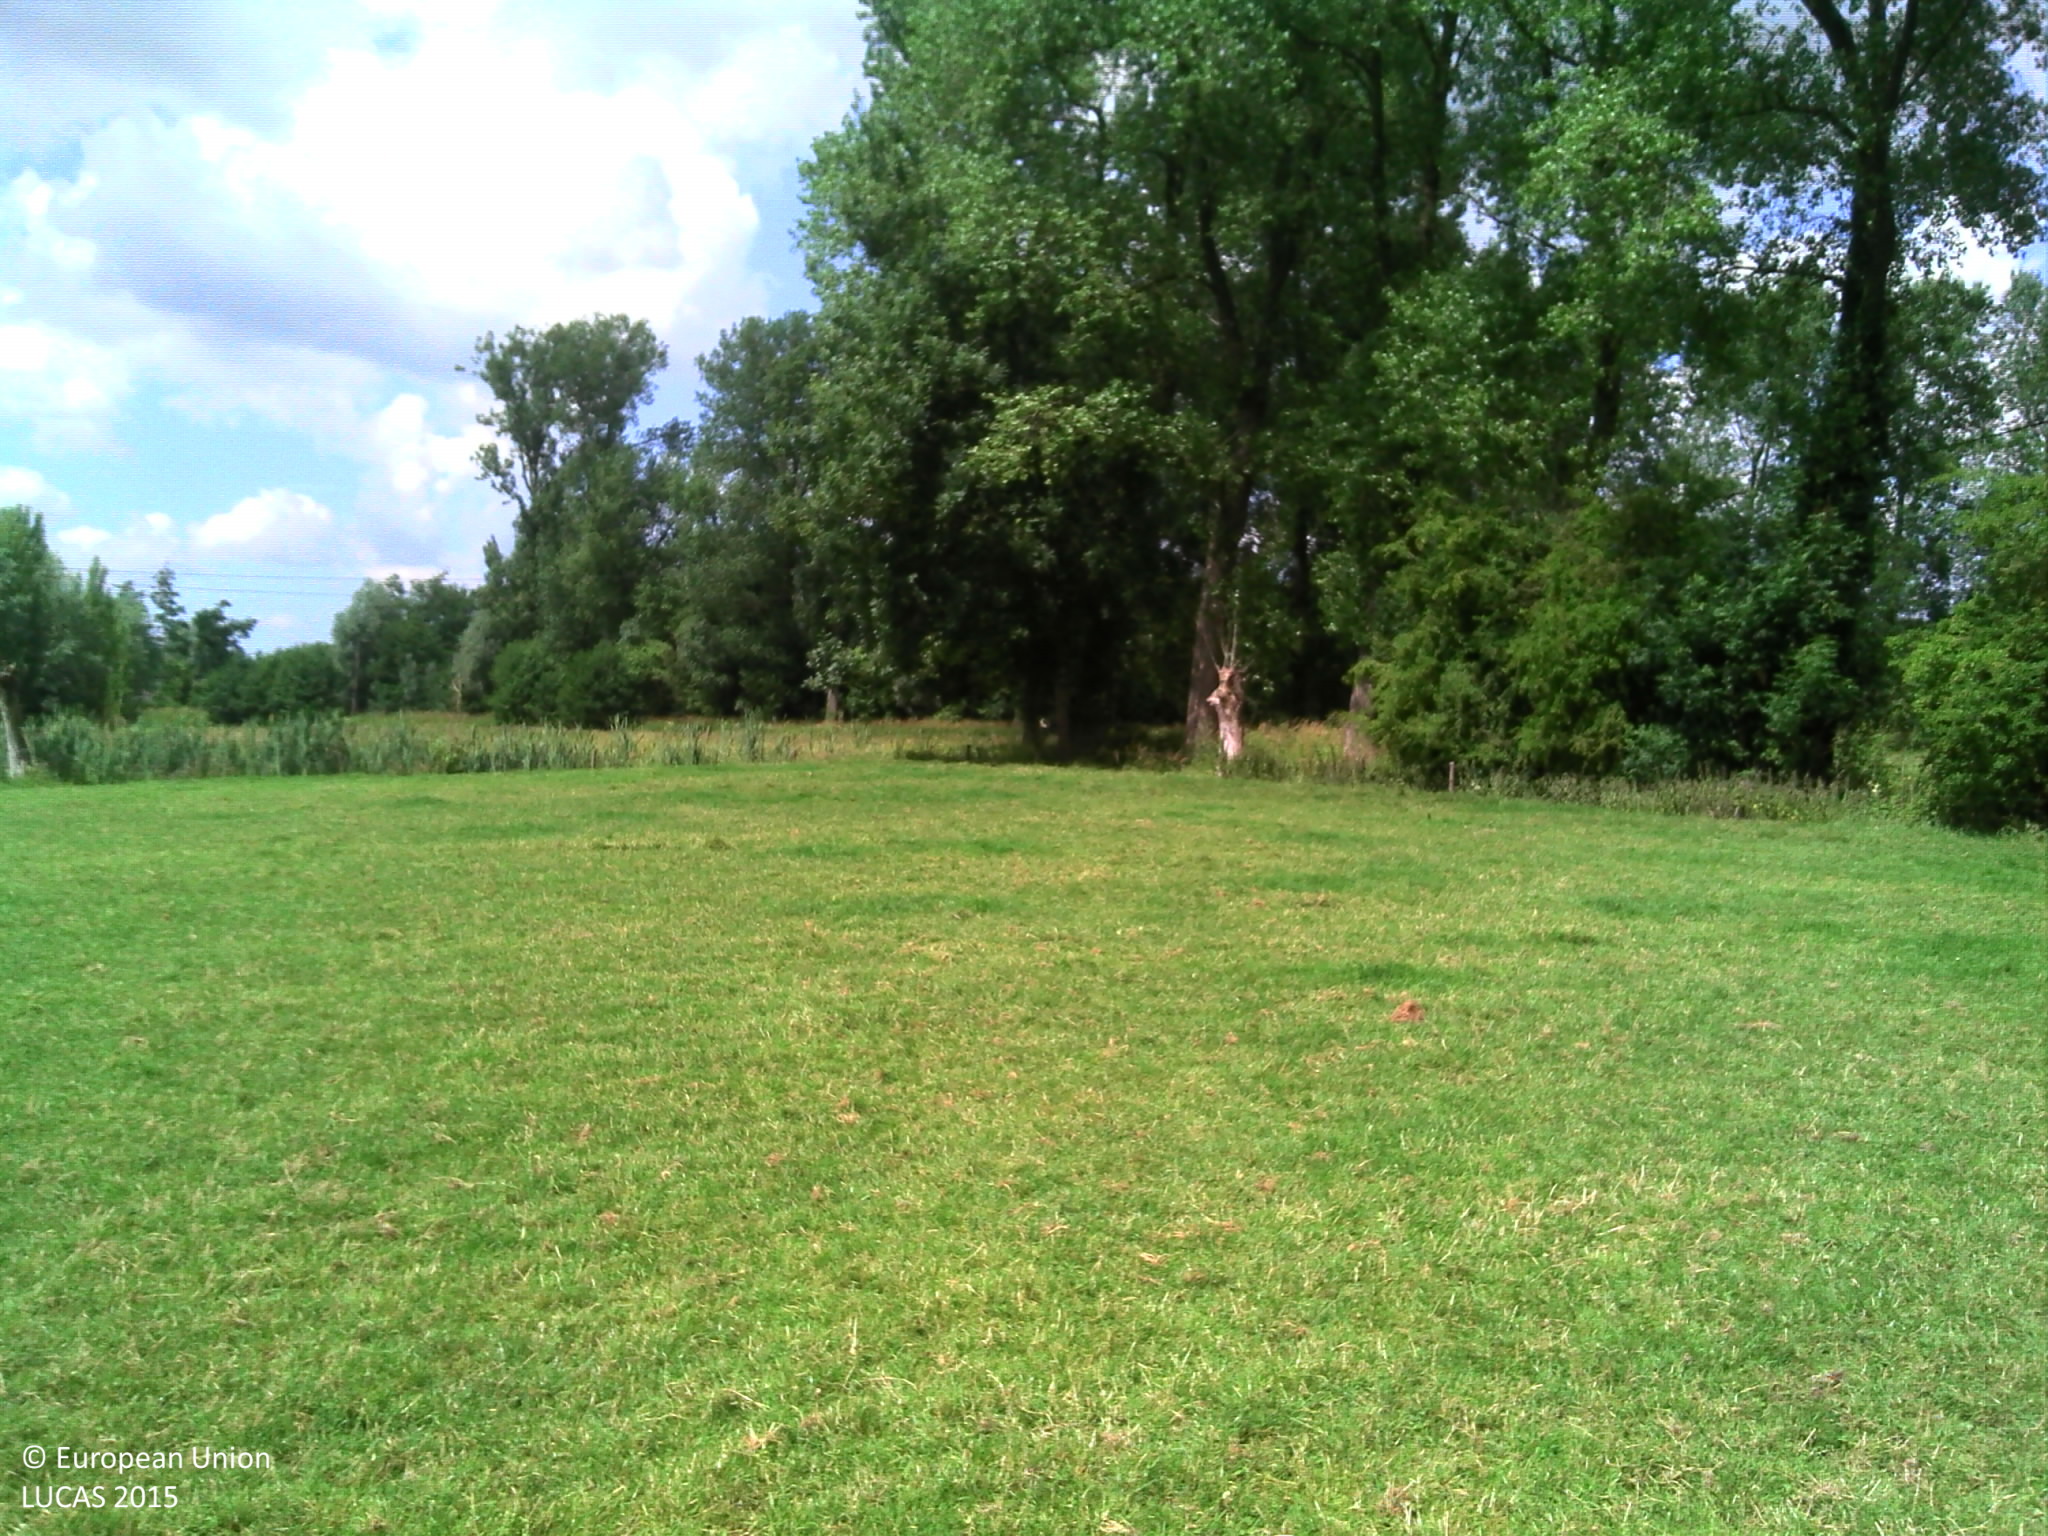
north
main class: Grassland
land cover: Grassland without tree/shrub cover
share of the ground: > 75 %
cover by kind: herbaceous plants 100 %
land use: Agriculture (excluding fallow land and kitchen gardens)
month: June
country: BE
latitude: 51.0678
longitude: 3.5850
